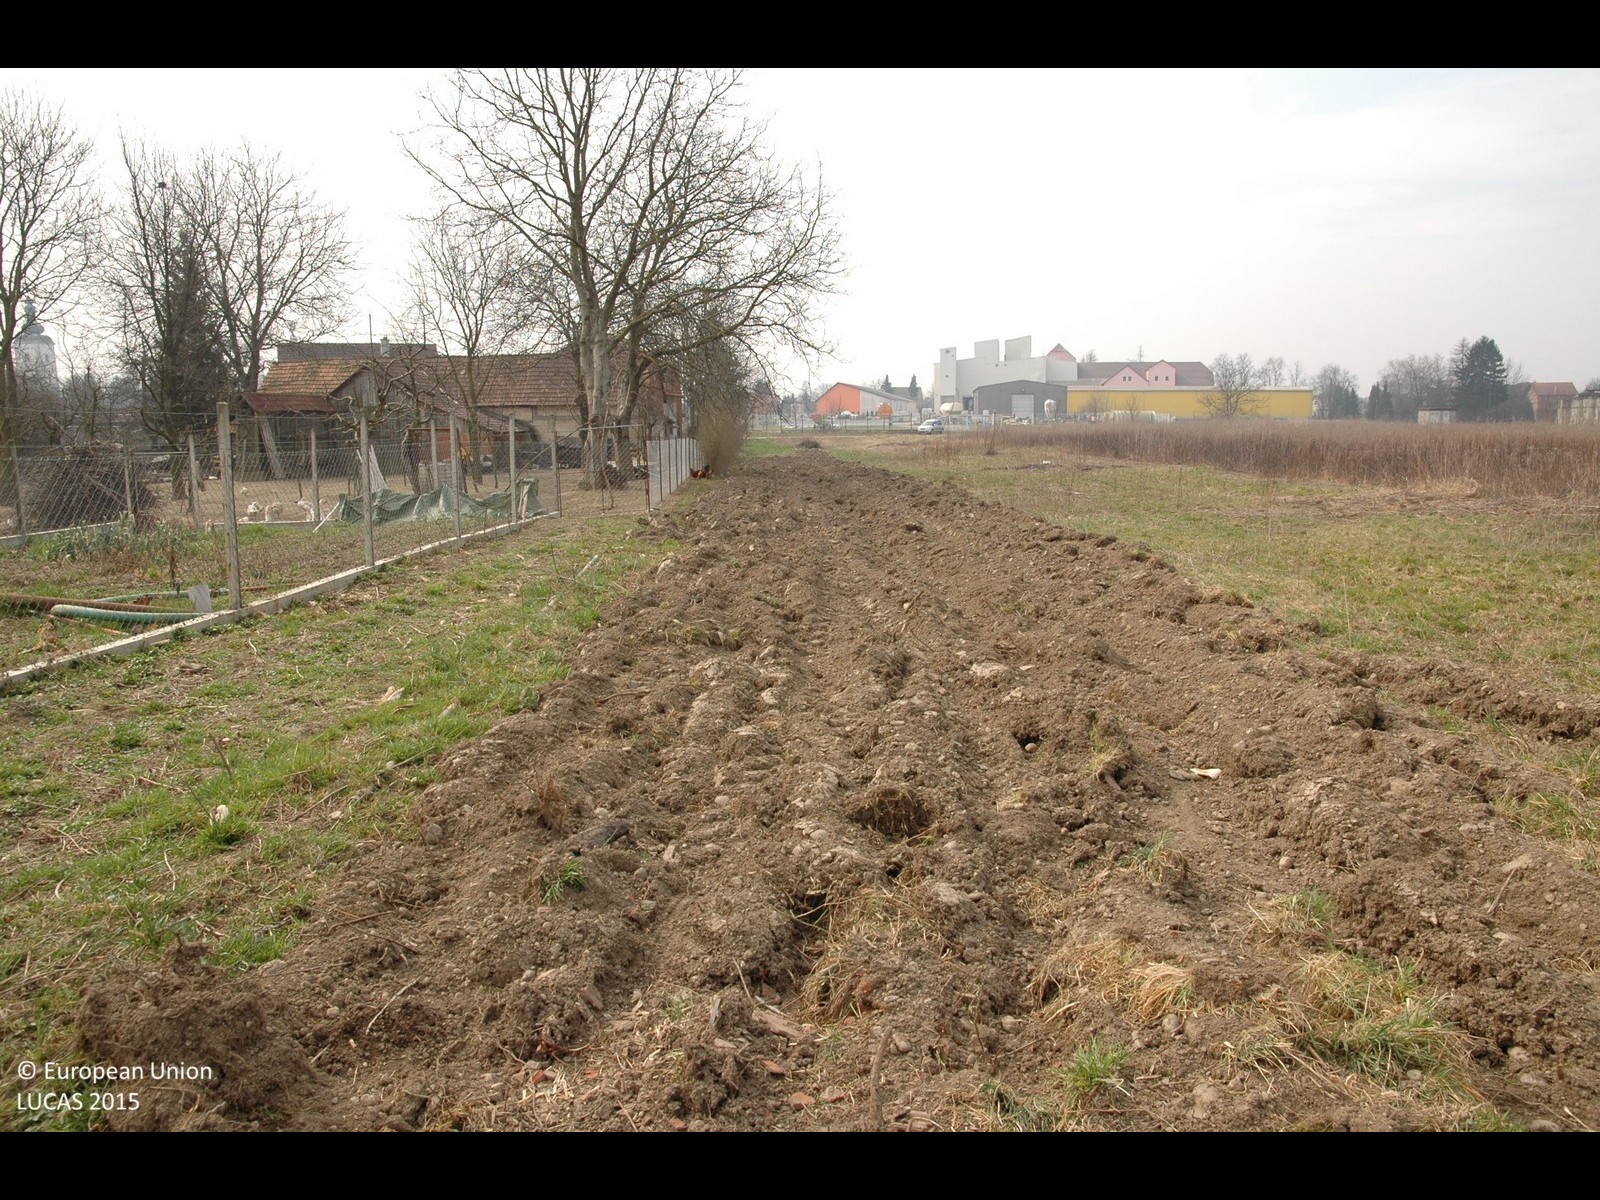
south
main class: Grassland
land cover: Grassland with sparse tree/shrub cover
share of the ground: > 75 %
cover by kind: herbaceous plants 95 %, broadleaved forest trees 5 %
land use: Agriculture (excluding fallow land and kitchen gardens)
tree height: > 5 m
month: March
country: HR
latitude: 46.3505
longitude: 16.2244
